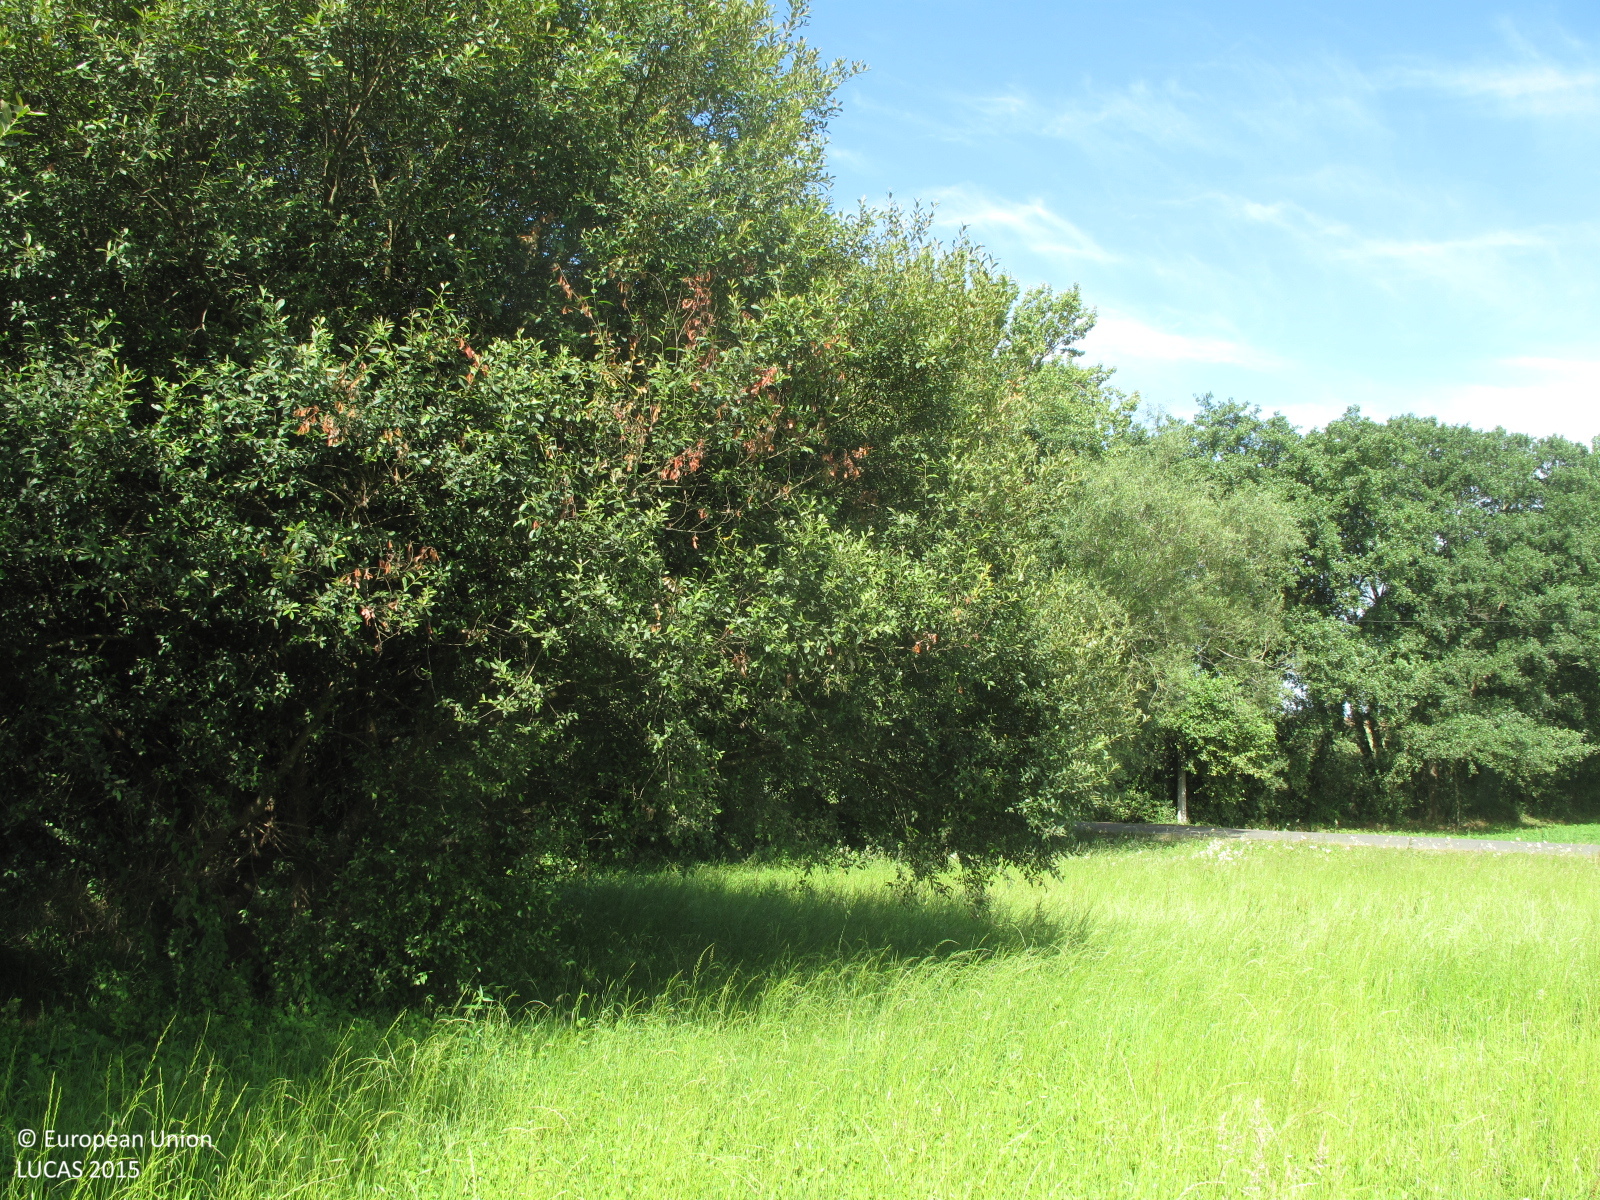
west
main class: Grassland
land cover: Grassland without tree/shrub cover
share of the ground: > 75 %
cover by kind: herbaceous plants 100 %
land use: Agriculture (excluding fallow land and kitchen gardens)
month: July
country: ES
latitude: 43.1982
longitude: -8.7346
